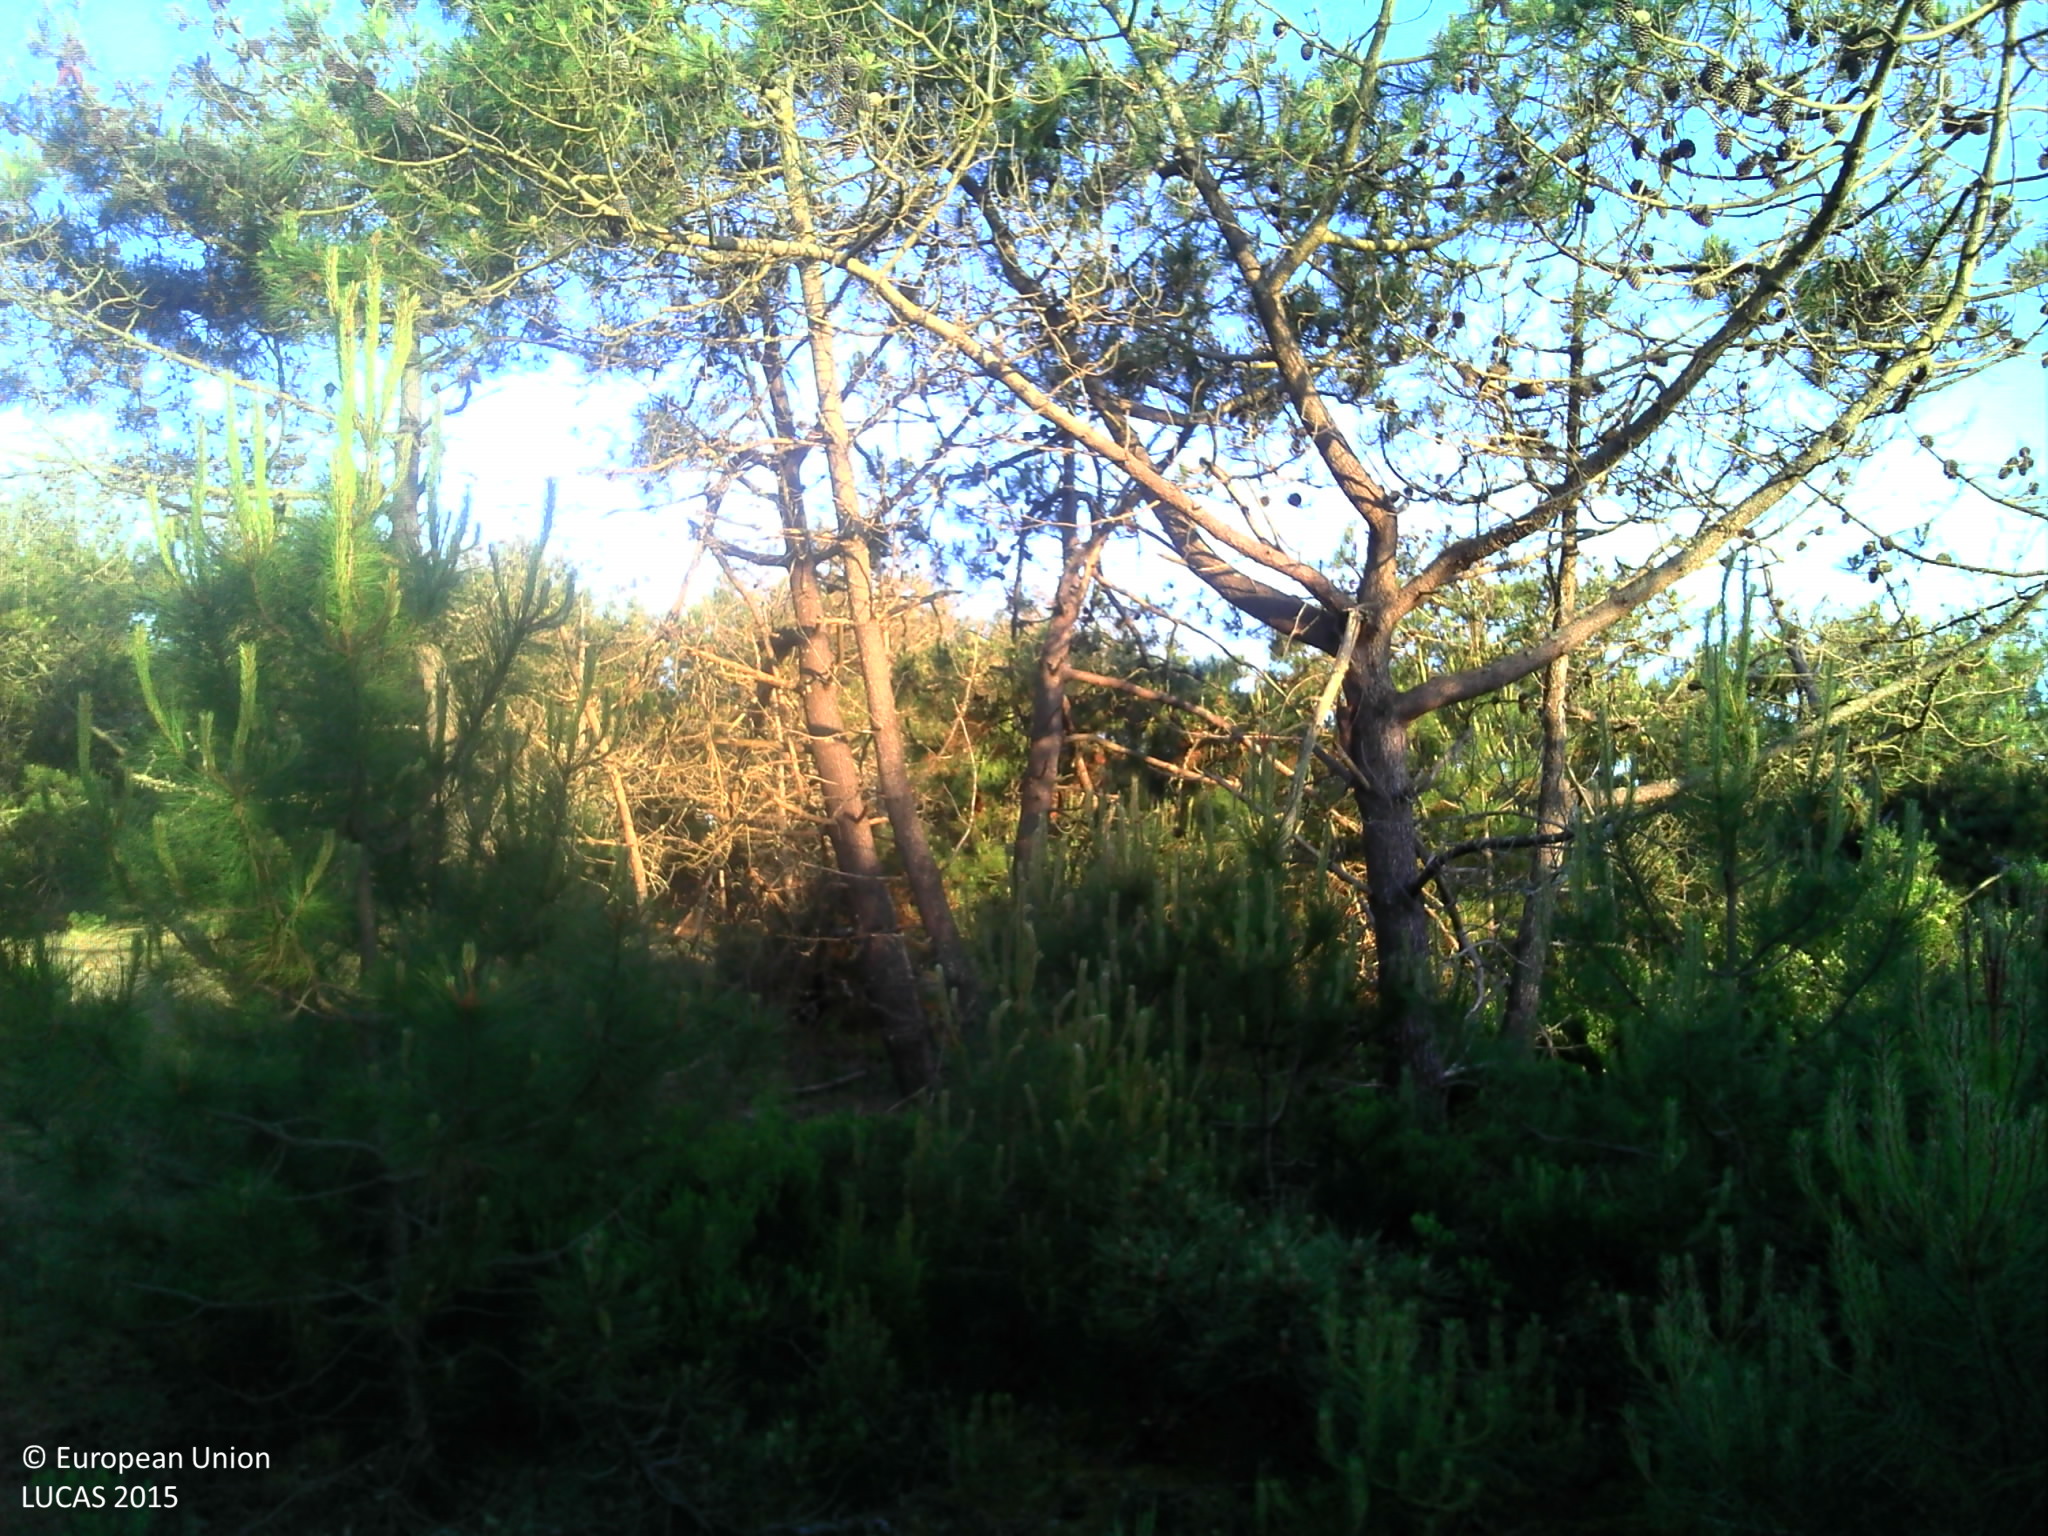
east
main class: Woodland
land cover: Pine dominated coniferous woodland
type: coniferous forest of the mediterranean region
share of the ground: > 75 %
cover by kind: coniferous forest trees 75 %, herbaceous plants 25 %
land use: Semi-natural and natural areas not in use
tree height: > 5 m
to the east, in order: Pine dominated coniferous woodland; Tracks; Inland marshes; Broadleaved woodland; Shrubland with sparse tree cover; Tracks; Broadleaved woodland
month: May
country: FR
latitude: 45.8469
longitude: -1.2471
